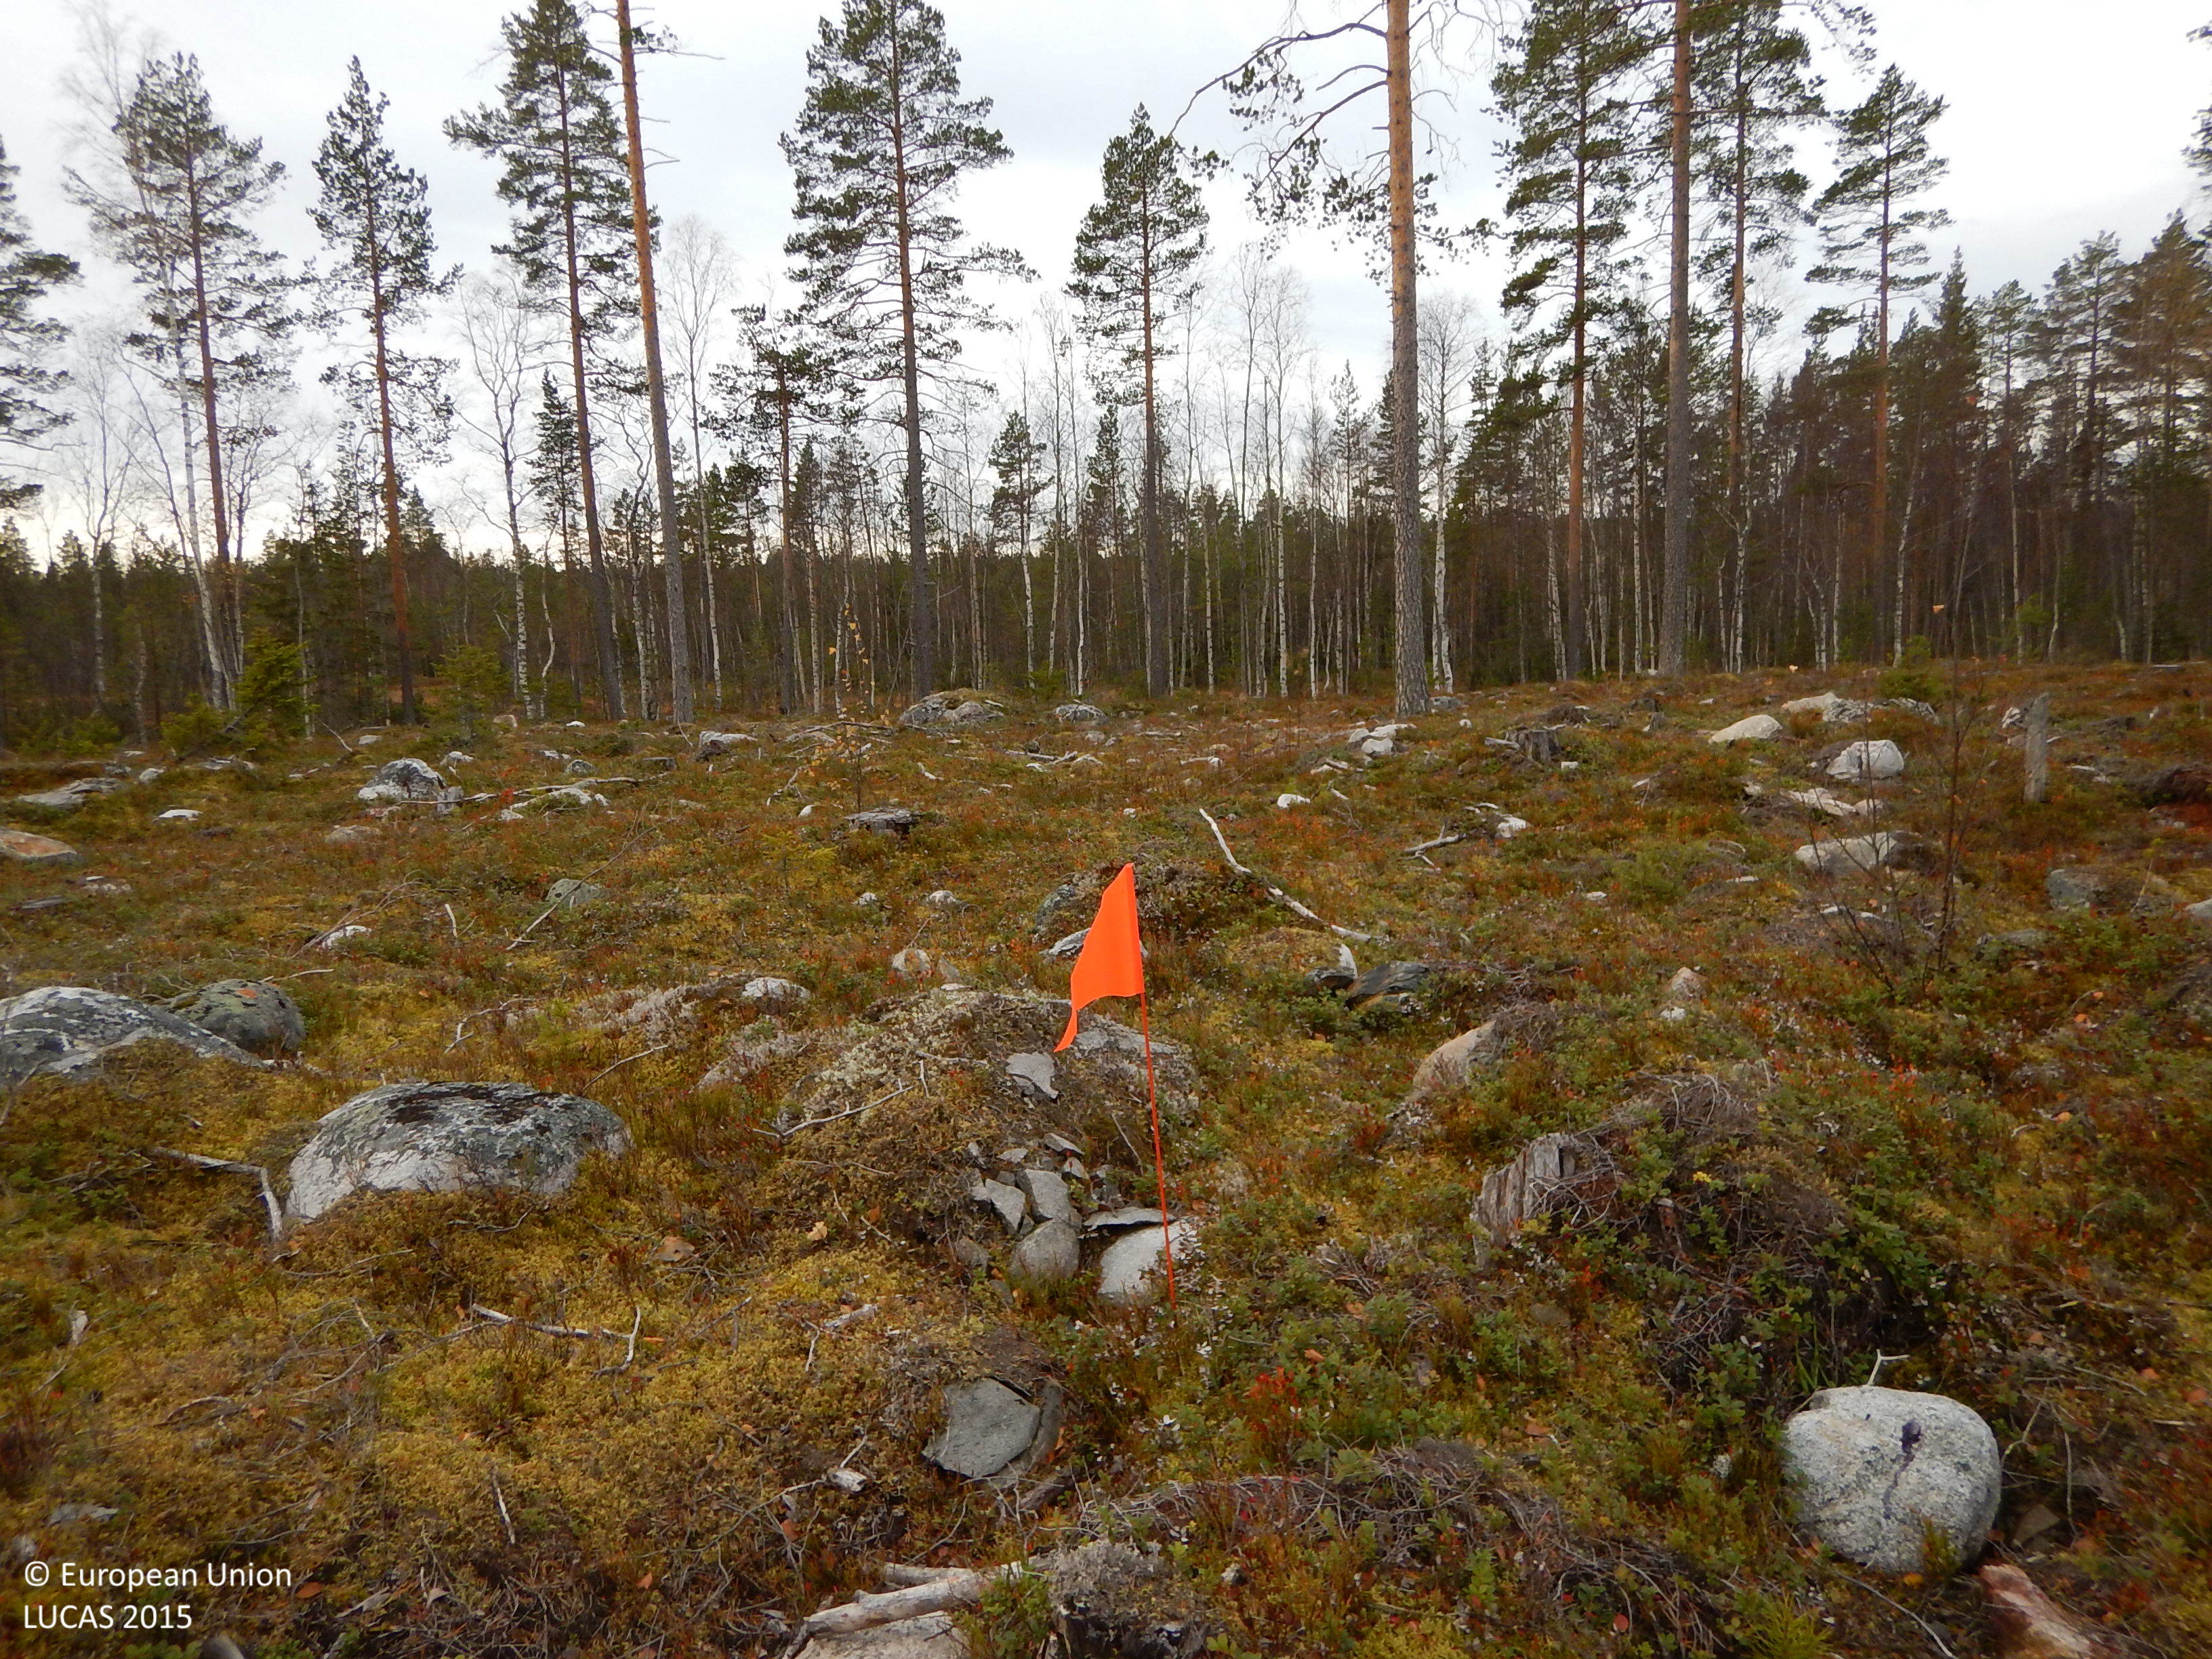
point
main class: Woodland
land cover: Pine dominated coniferous woodland
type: boreal forest
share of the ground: 10 - 25 %
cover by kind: lichens and mosses 40 %, shrubs 30 %, herbaceous plants 20 %, coniferous forest trees 10 %
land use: Forestry
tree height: > 5 m
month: October
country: SE
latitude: 65.1808
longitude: 21.0554
